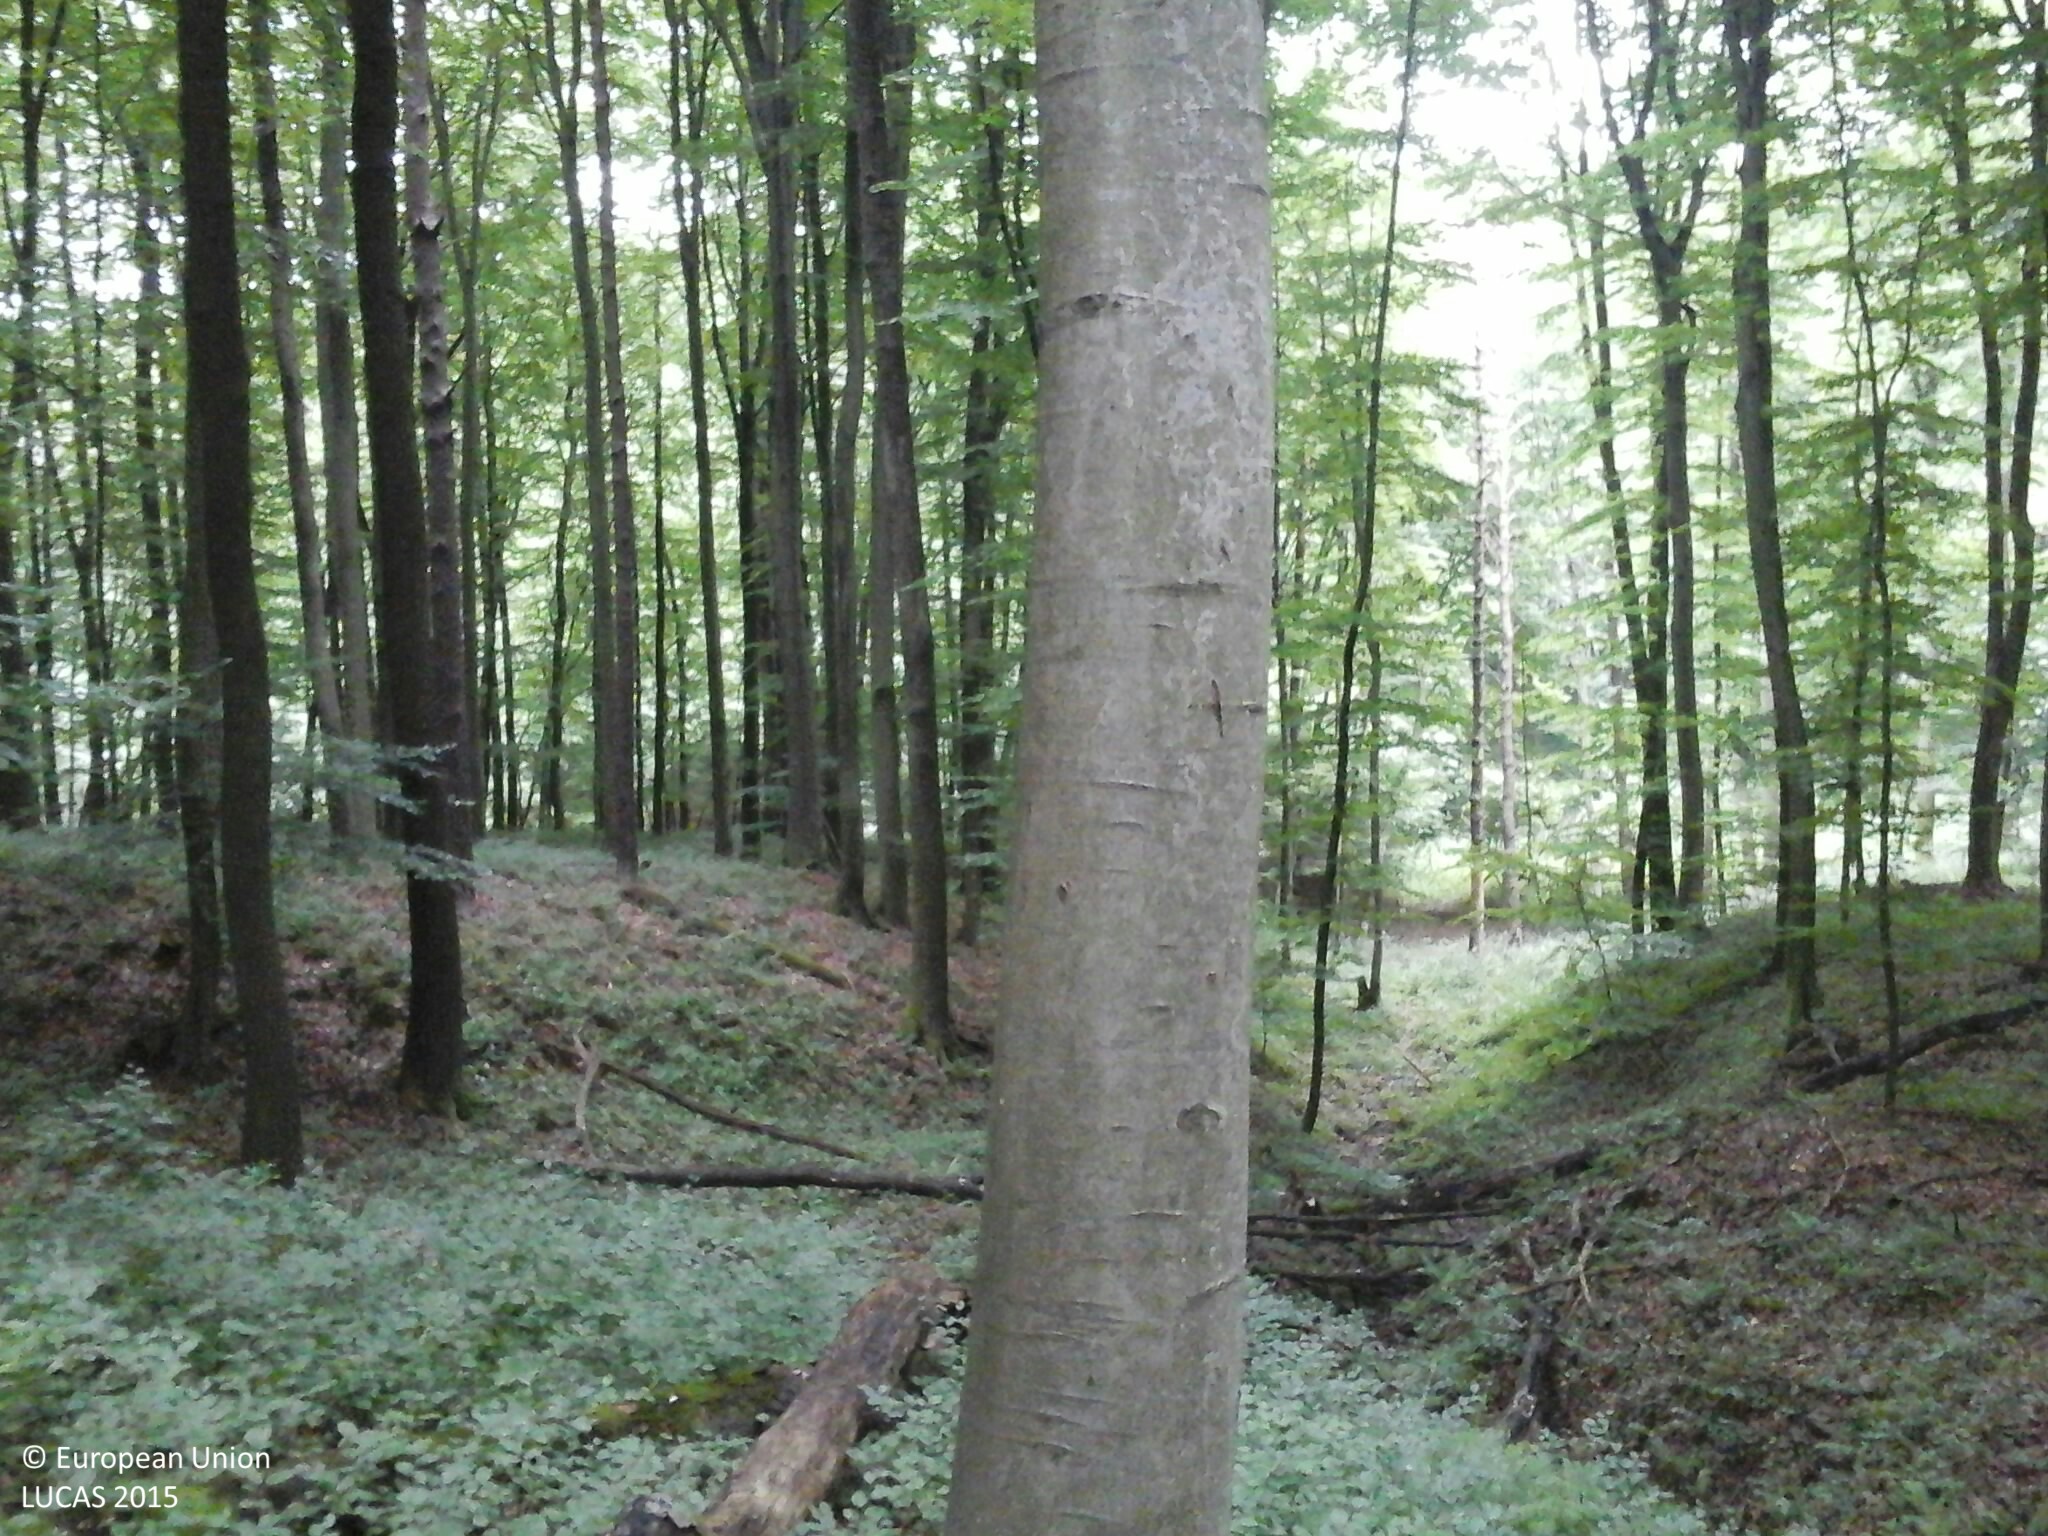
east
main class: Woodland
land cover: Broadleaved woodland
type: beech forest
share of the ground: > 75 %
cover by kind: broadleaved forest trees 95 %, shrubs 5 %
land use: Forestry
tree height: > 5 m
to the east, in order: Broadleaved woodland; Ditches and canals; Tracks; Broadleaved woodland
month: July
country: HU
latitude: 46.8161
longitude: 16.5948
